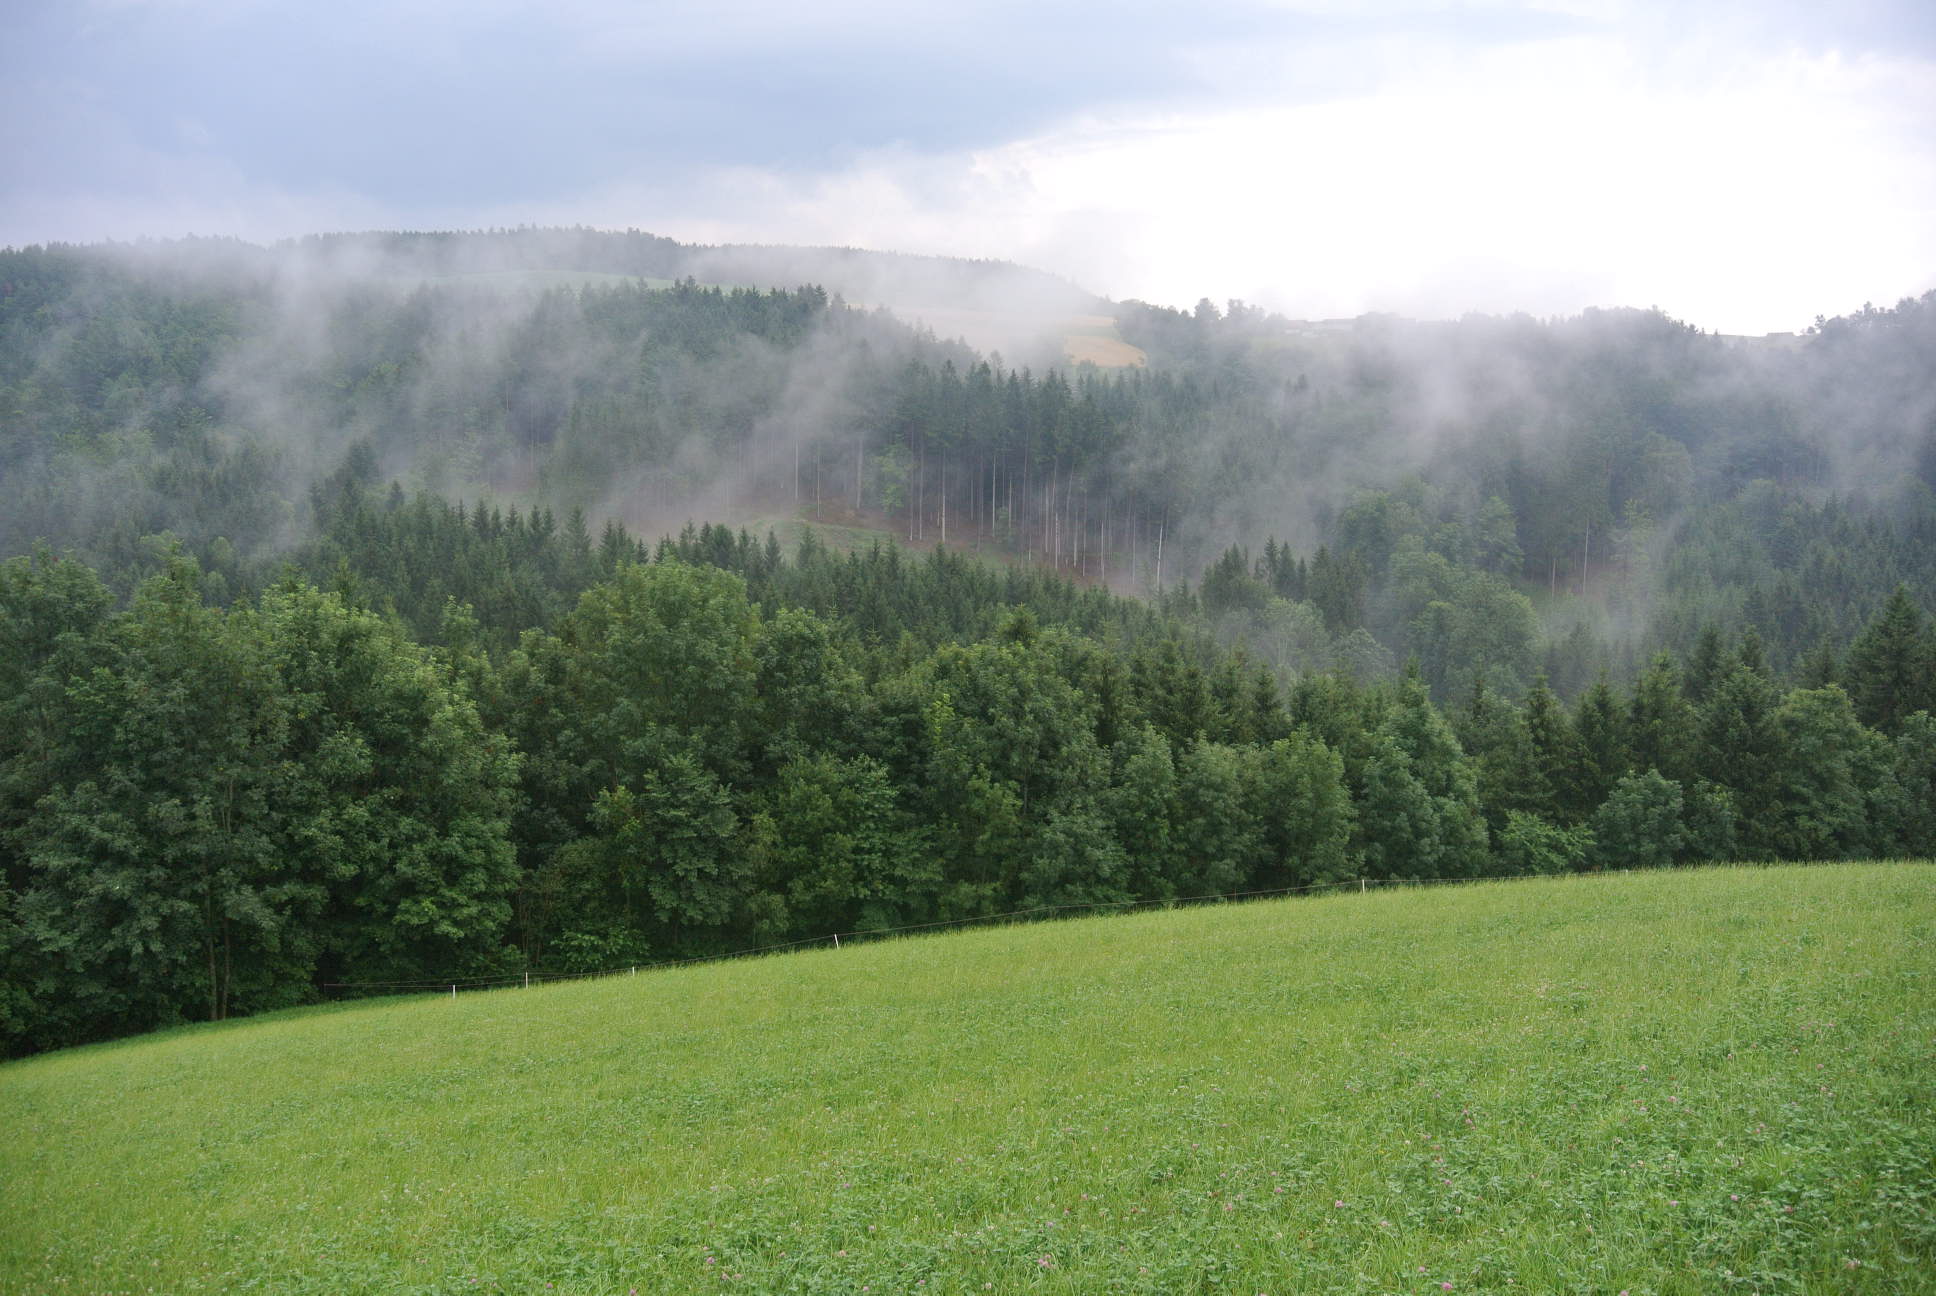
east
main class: Grassland
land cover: Grassland without tree/shrub cover
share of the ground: > 75 %
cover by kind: herbaceous plants 100 %
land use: Agriculture (excluding fallow land and kitchen gardens)
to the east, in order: Grassland without tree/shrub cover; Fences; Grassland without tree/shrub cover; Fences; Broadleaved woodland; Spruce dominated coniferous woodland; Tracks; Spruce dominated coniferous woodland; Rivers and streams; Grassland without tree/shrub cover; Tracks; Grassland without tree/shrub cover; Electric lines; Grassland without tree/shrub cover; Spruce dominated coniferous woodland
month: July
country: AT
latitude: 47.4730
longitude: 16.1725
